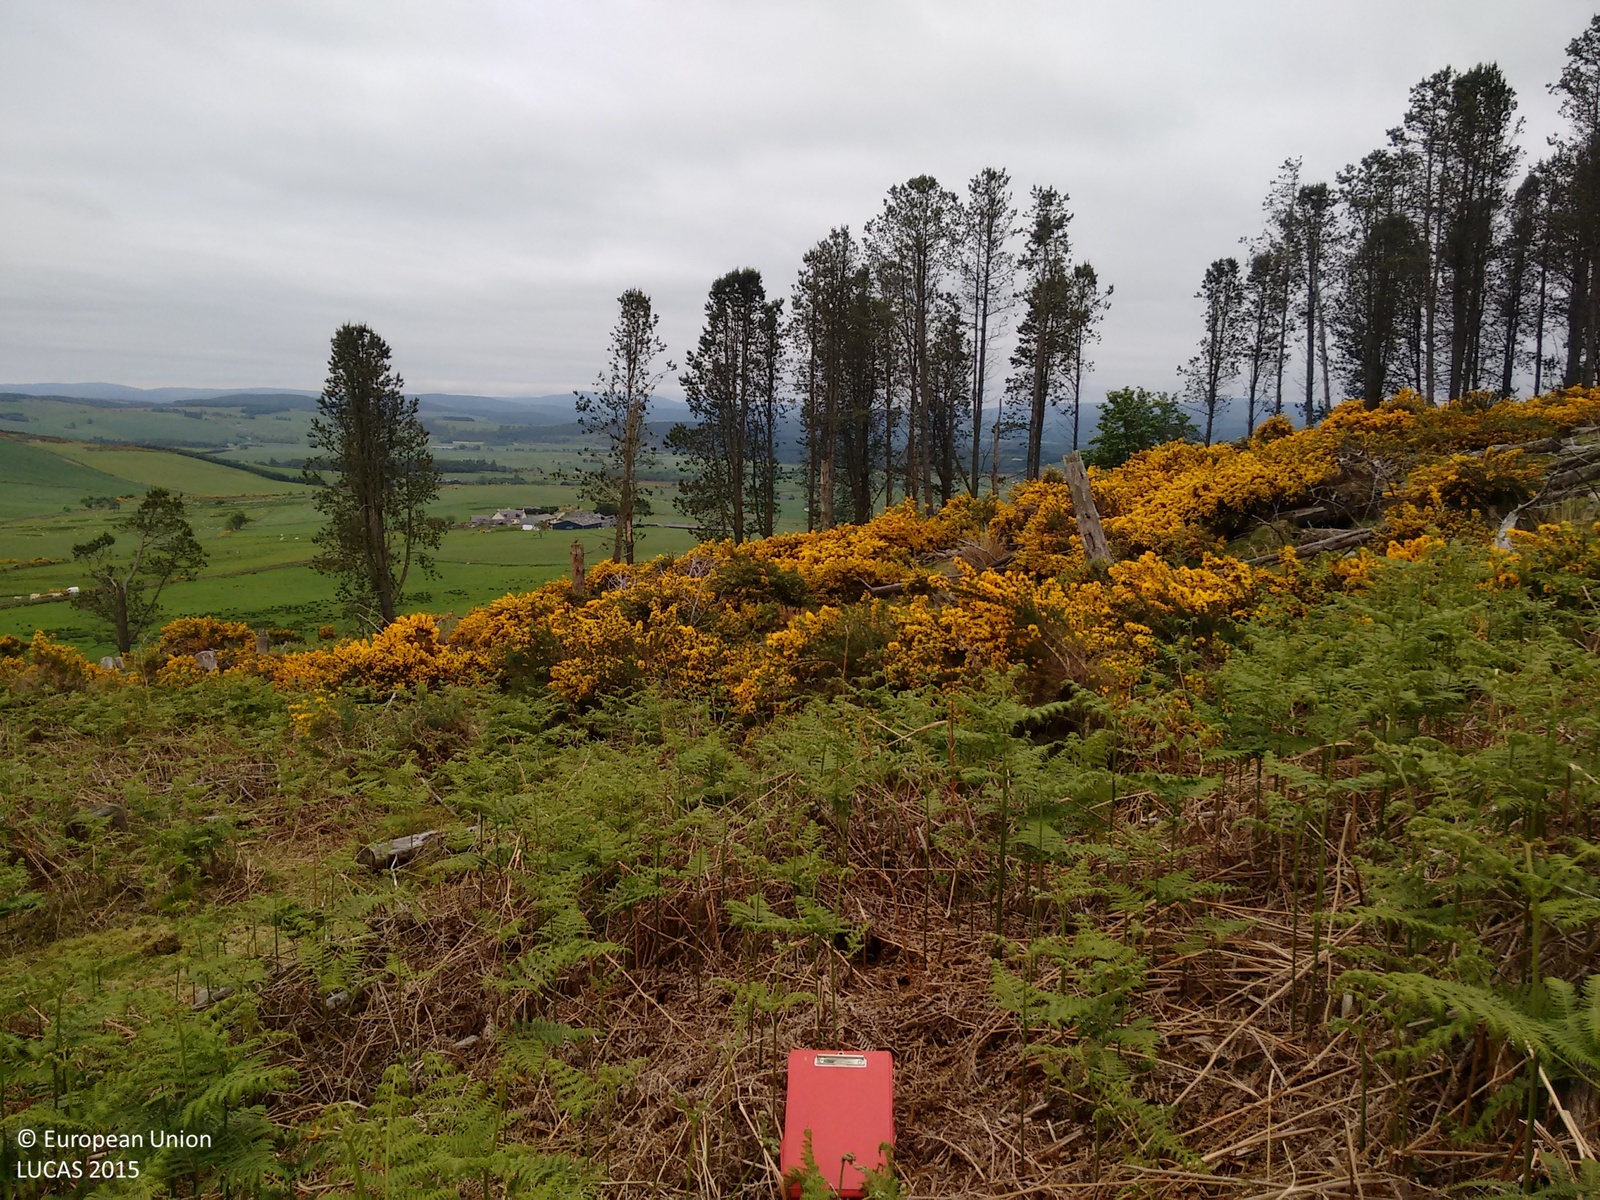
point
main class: Shrubland
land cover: Shrubland without tree cover
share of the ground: 50 - 75 %
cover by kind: shrubs 60 %, herbaceous plants 40 %
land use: Semi-natural and natural areas not in use
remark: Clear cut
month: June
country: GB
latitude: 57.1333
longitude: -2.7642
